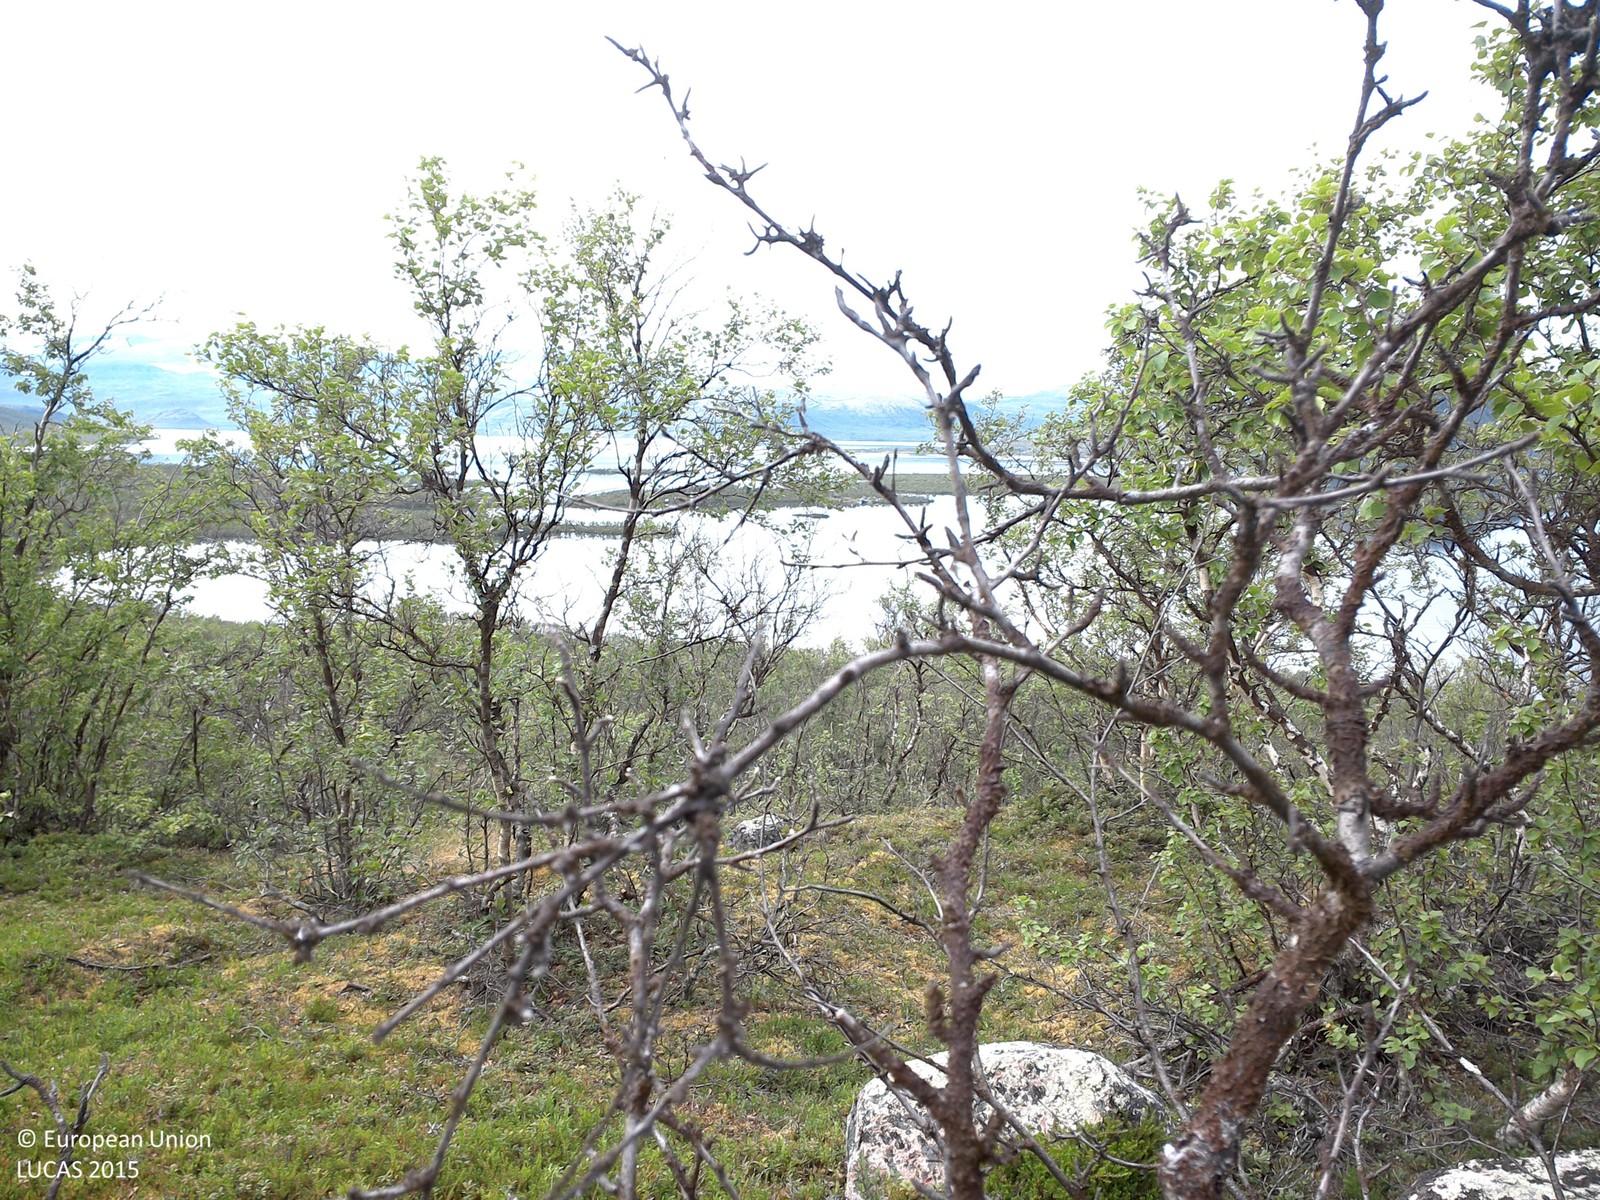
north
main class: Woodland
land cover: Broadleaved woodland
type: boreal forest
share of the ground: 10 - 25 %
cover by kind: shrubs 60 %, broadleaved forest trees 20 %, lichens and mosses 20 %
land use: Forestry
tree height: < 5 m
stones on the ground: > 50 %
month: August
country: SE
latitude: 68.2360
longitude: 19.5276
